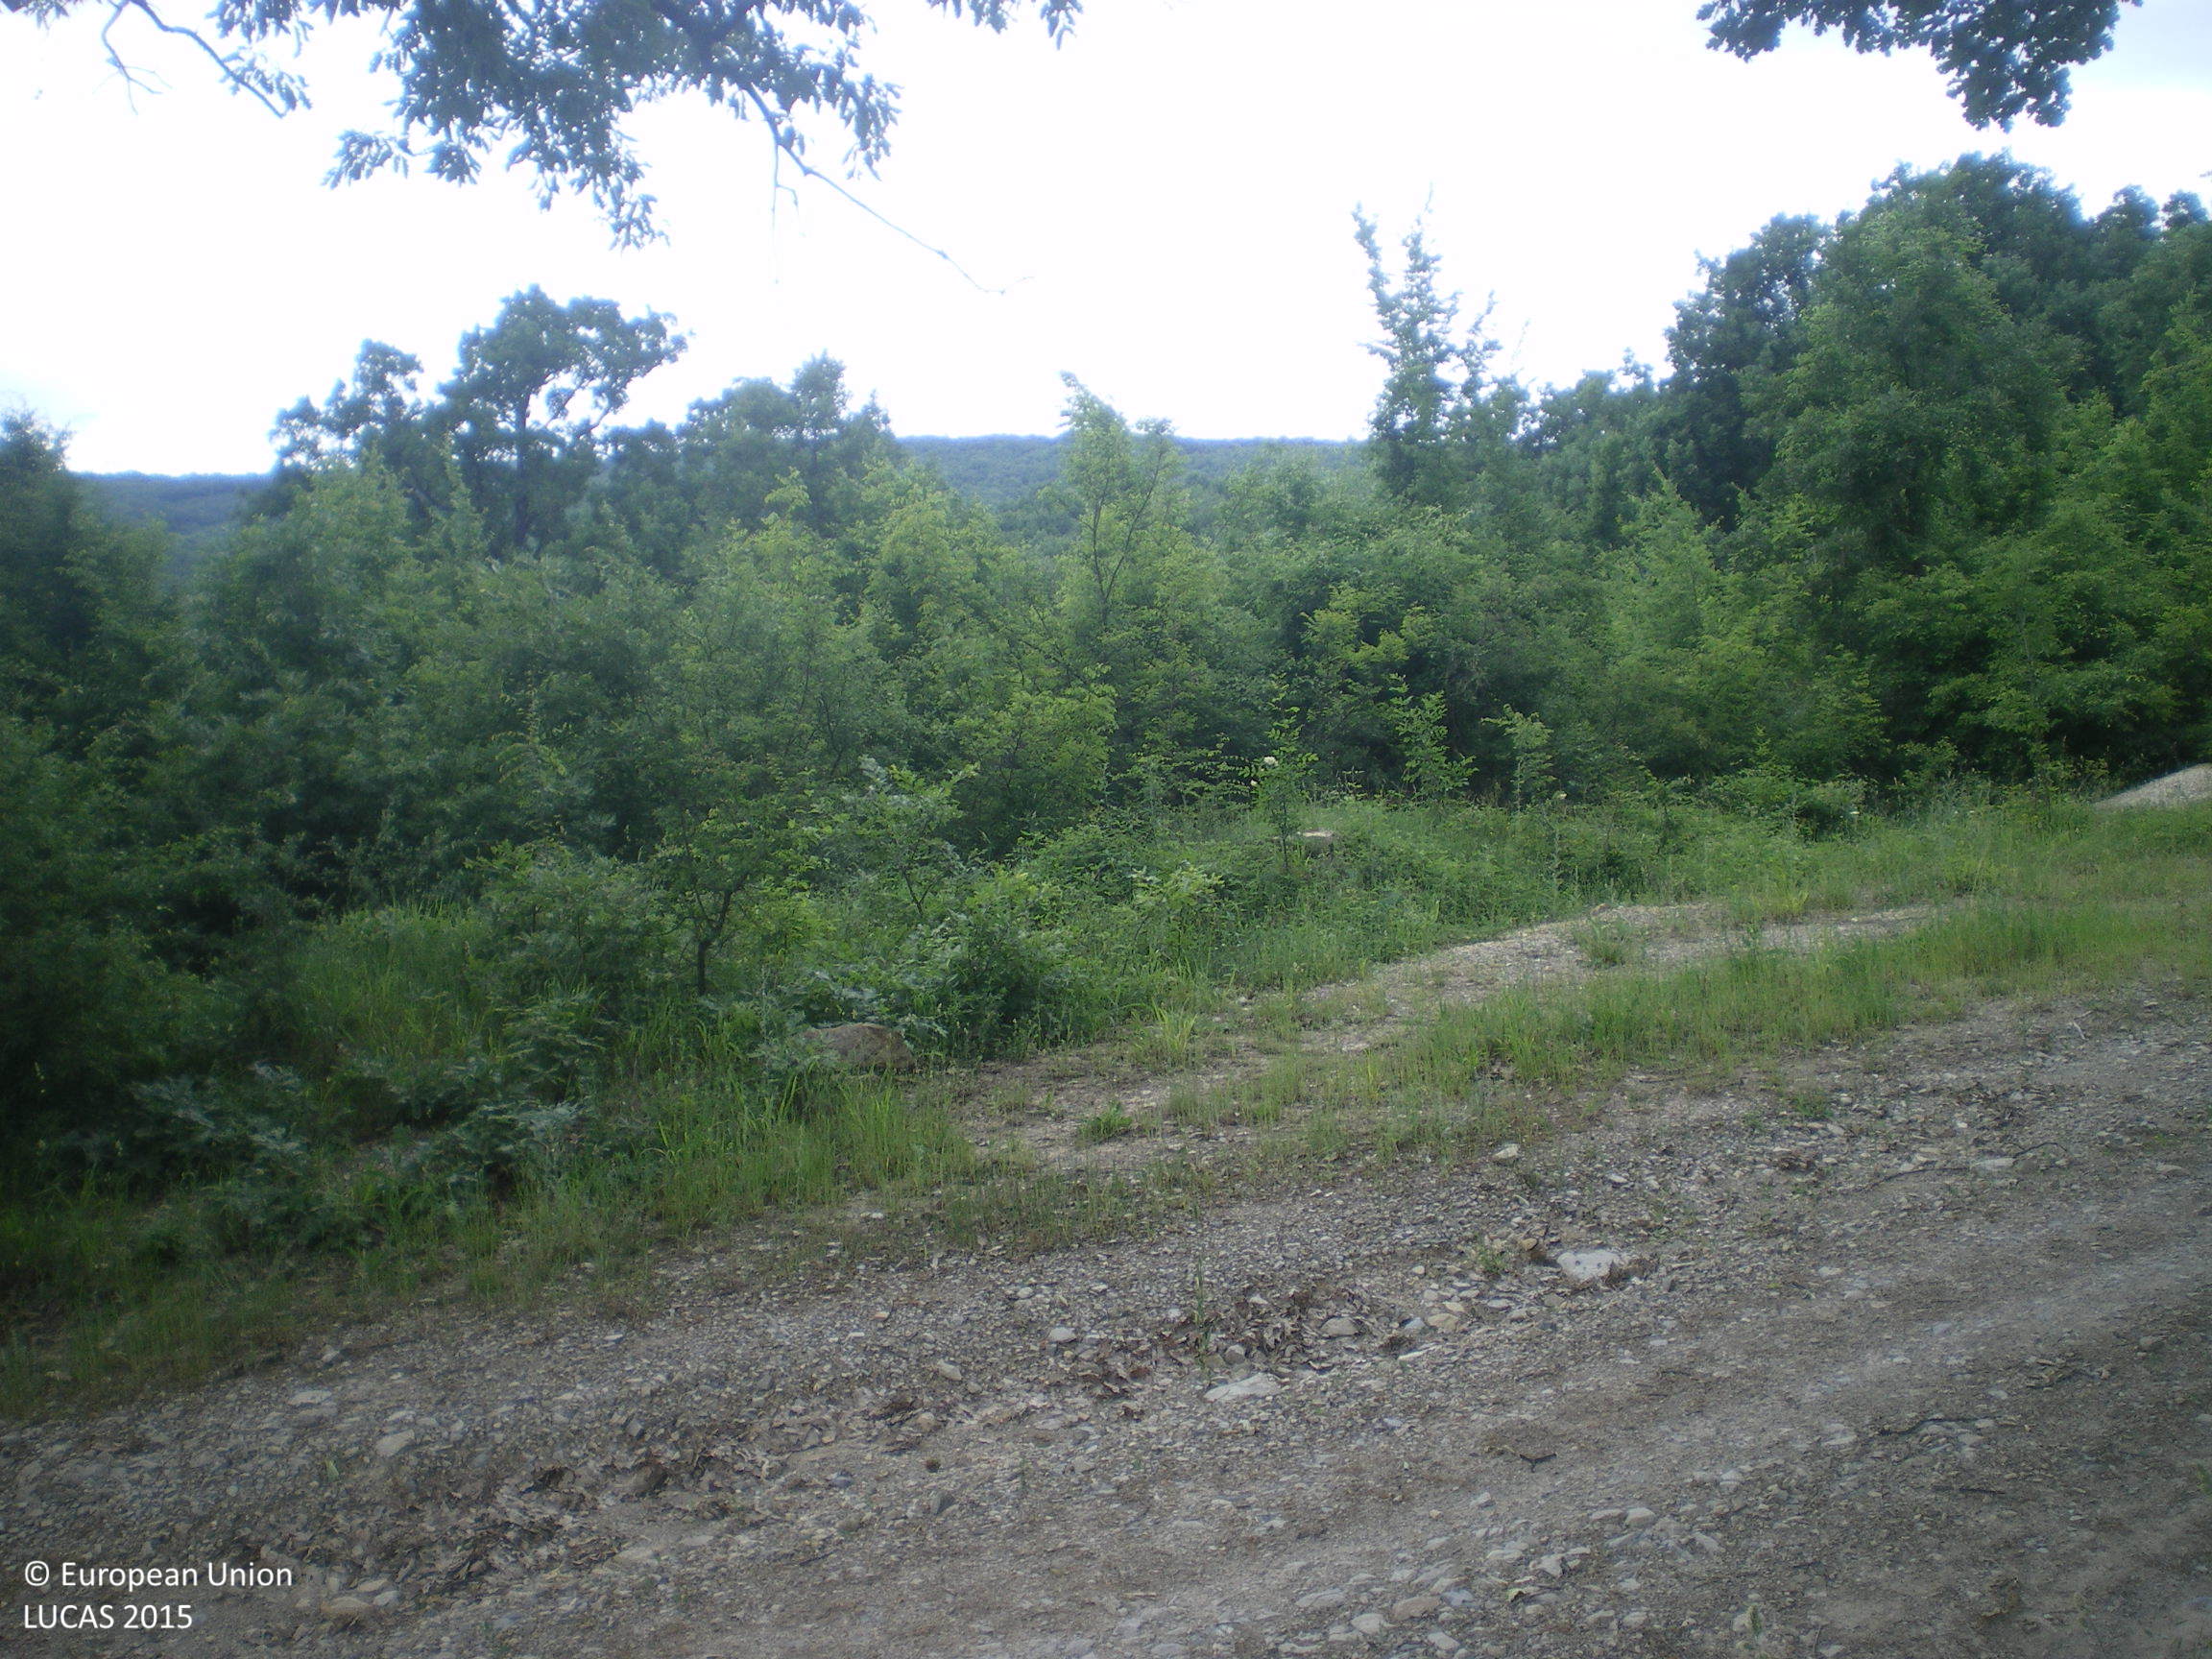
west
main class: Woodland
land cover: Broadleaved woodland
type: mesophytic deciduous forest
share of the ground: > 75 %
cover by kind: broadleaved forest trees 70 %, shrubs 20 %, herbaceous plants 10 %
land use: Forestry
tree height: > 5 m
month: May
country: BG
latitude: 42.2786
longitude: 25.3800
